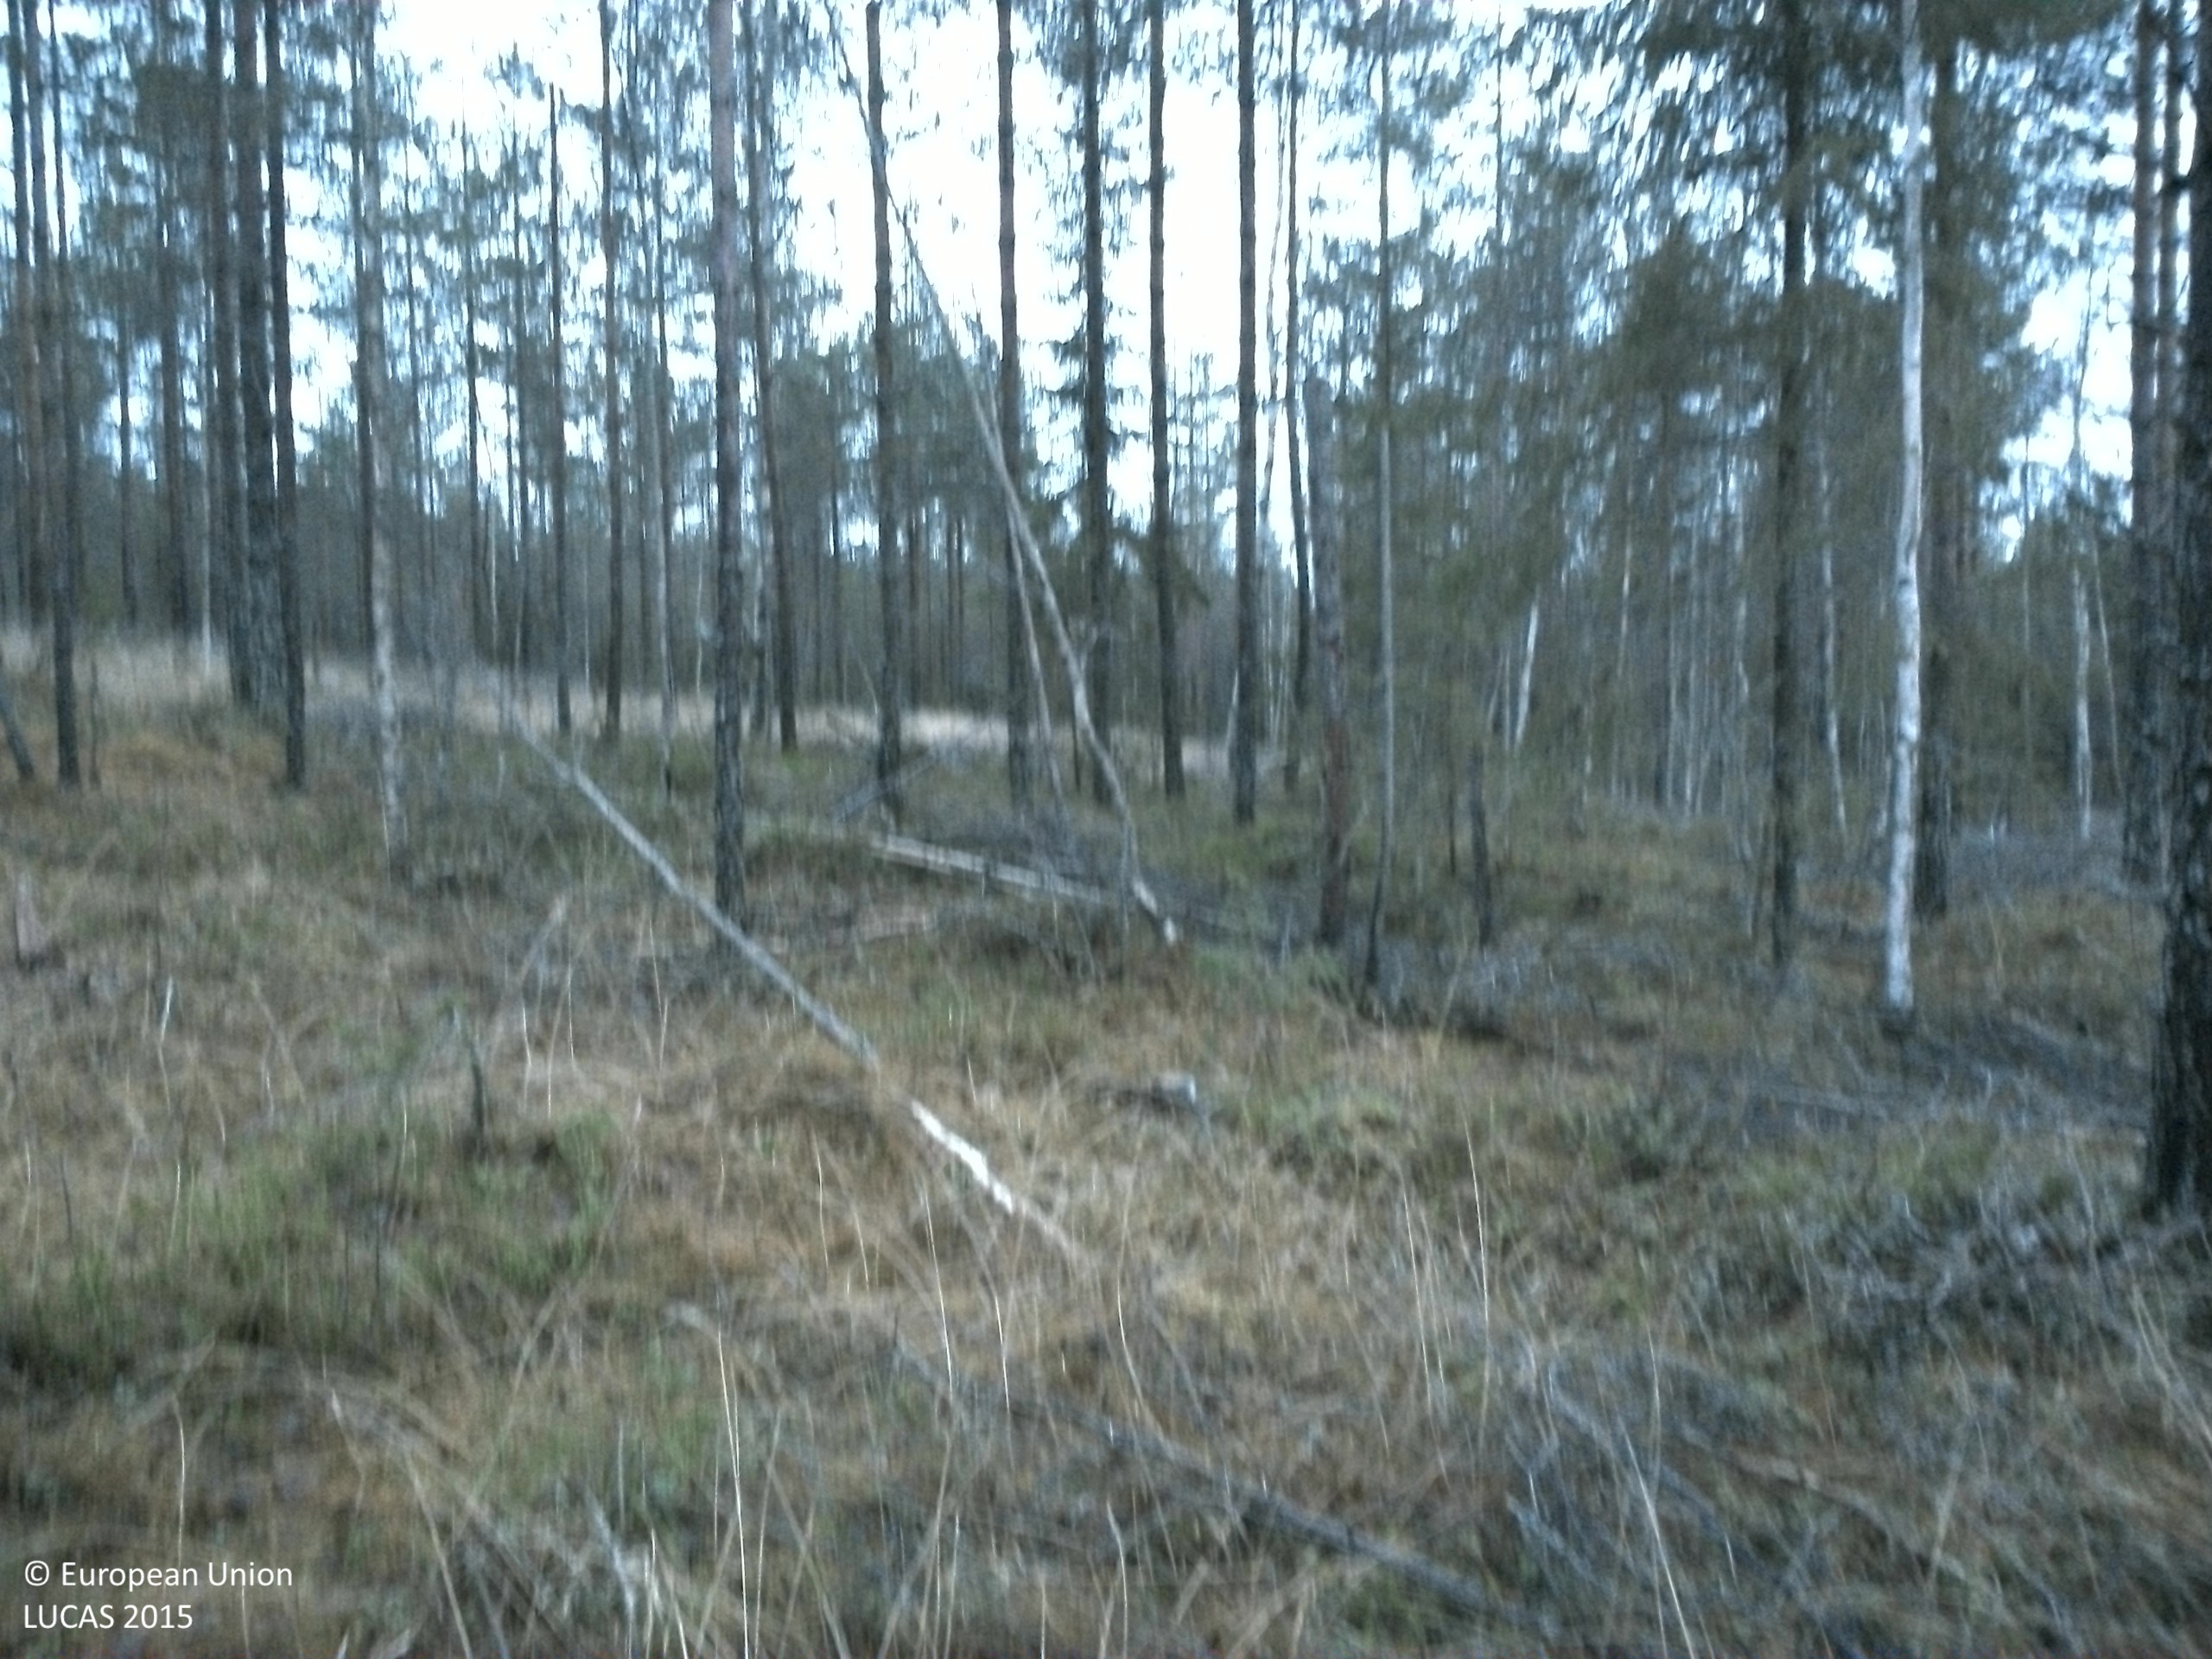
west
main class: Woodland
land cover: Pine dominated coniferous woodland
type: boreal forest
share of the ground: 25 - 50 %
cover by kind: coniferous forest trees 35 %, herbaceous plants 30 %, shrubs 20 %, lichens and mosses 10 %, broadleaved forest trees 5 %
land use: Forestry
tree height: > 5 m
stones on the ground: < 10 %
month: November
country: SE
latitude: 59.8662
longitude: 15.2579
